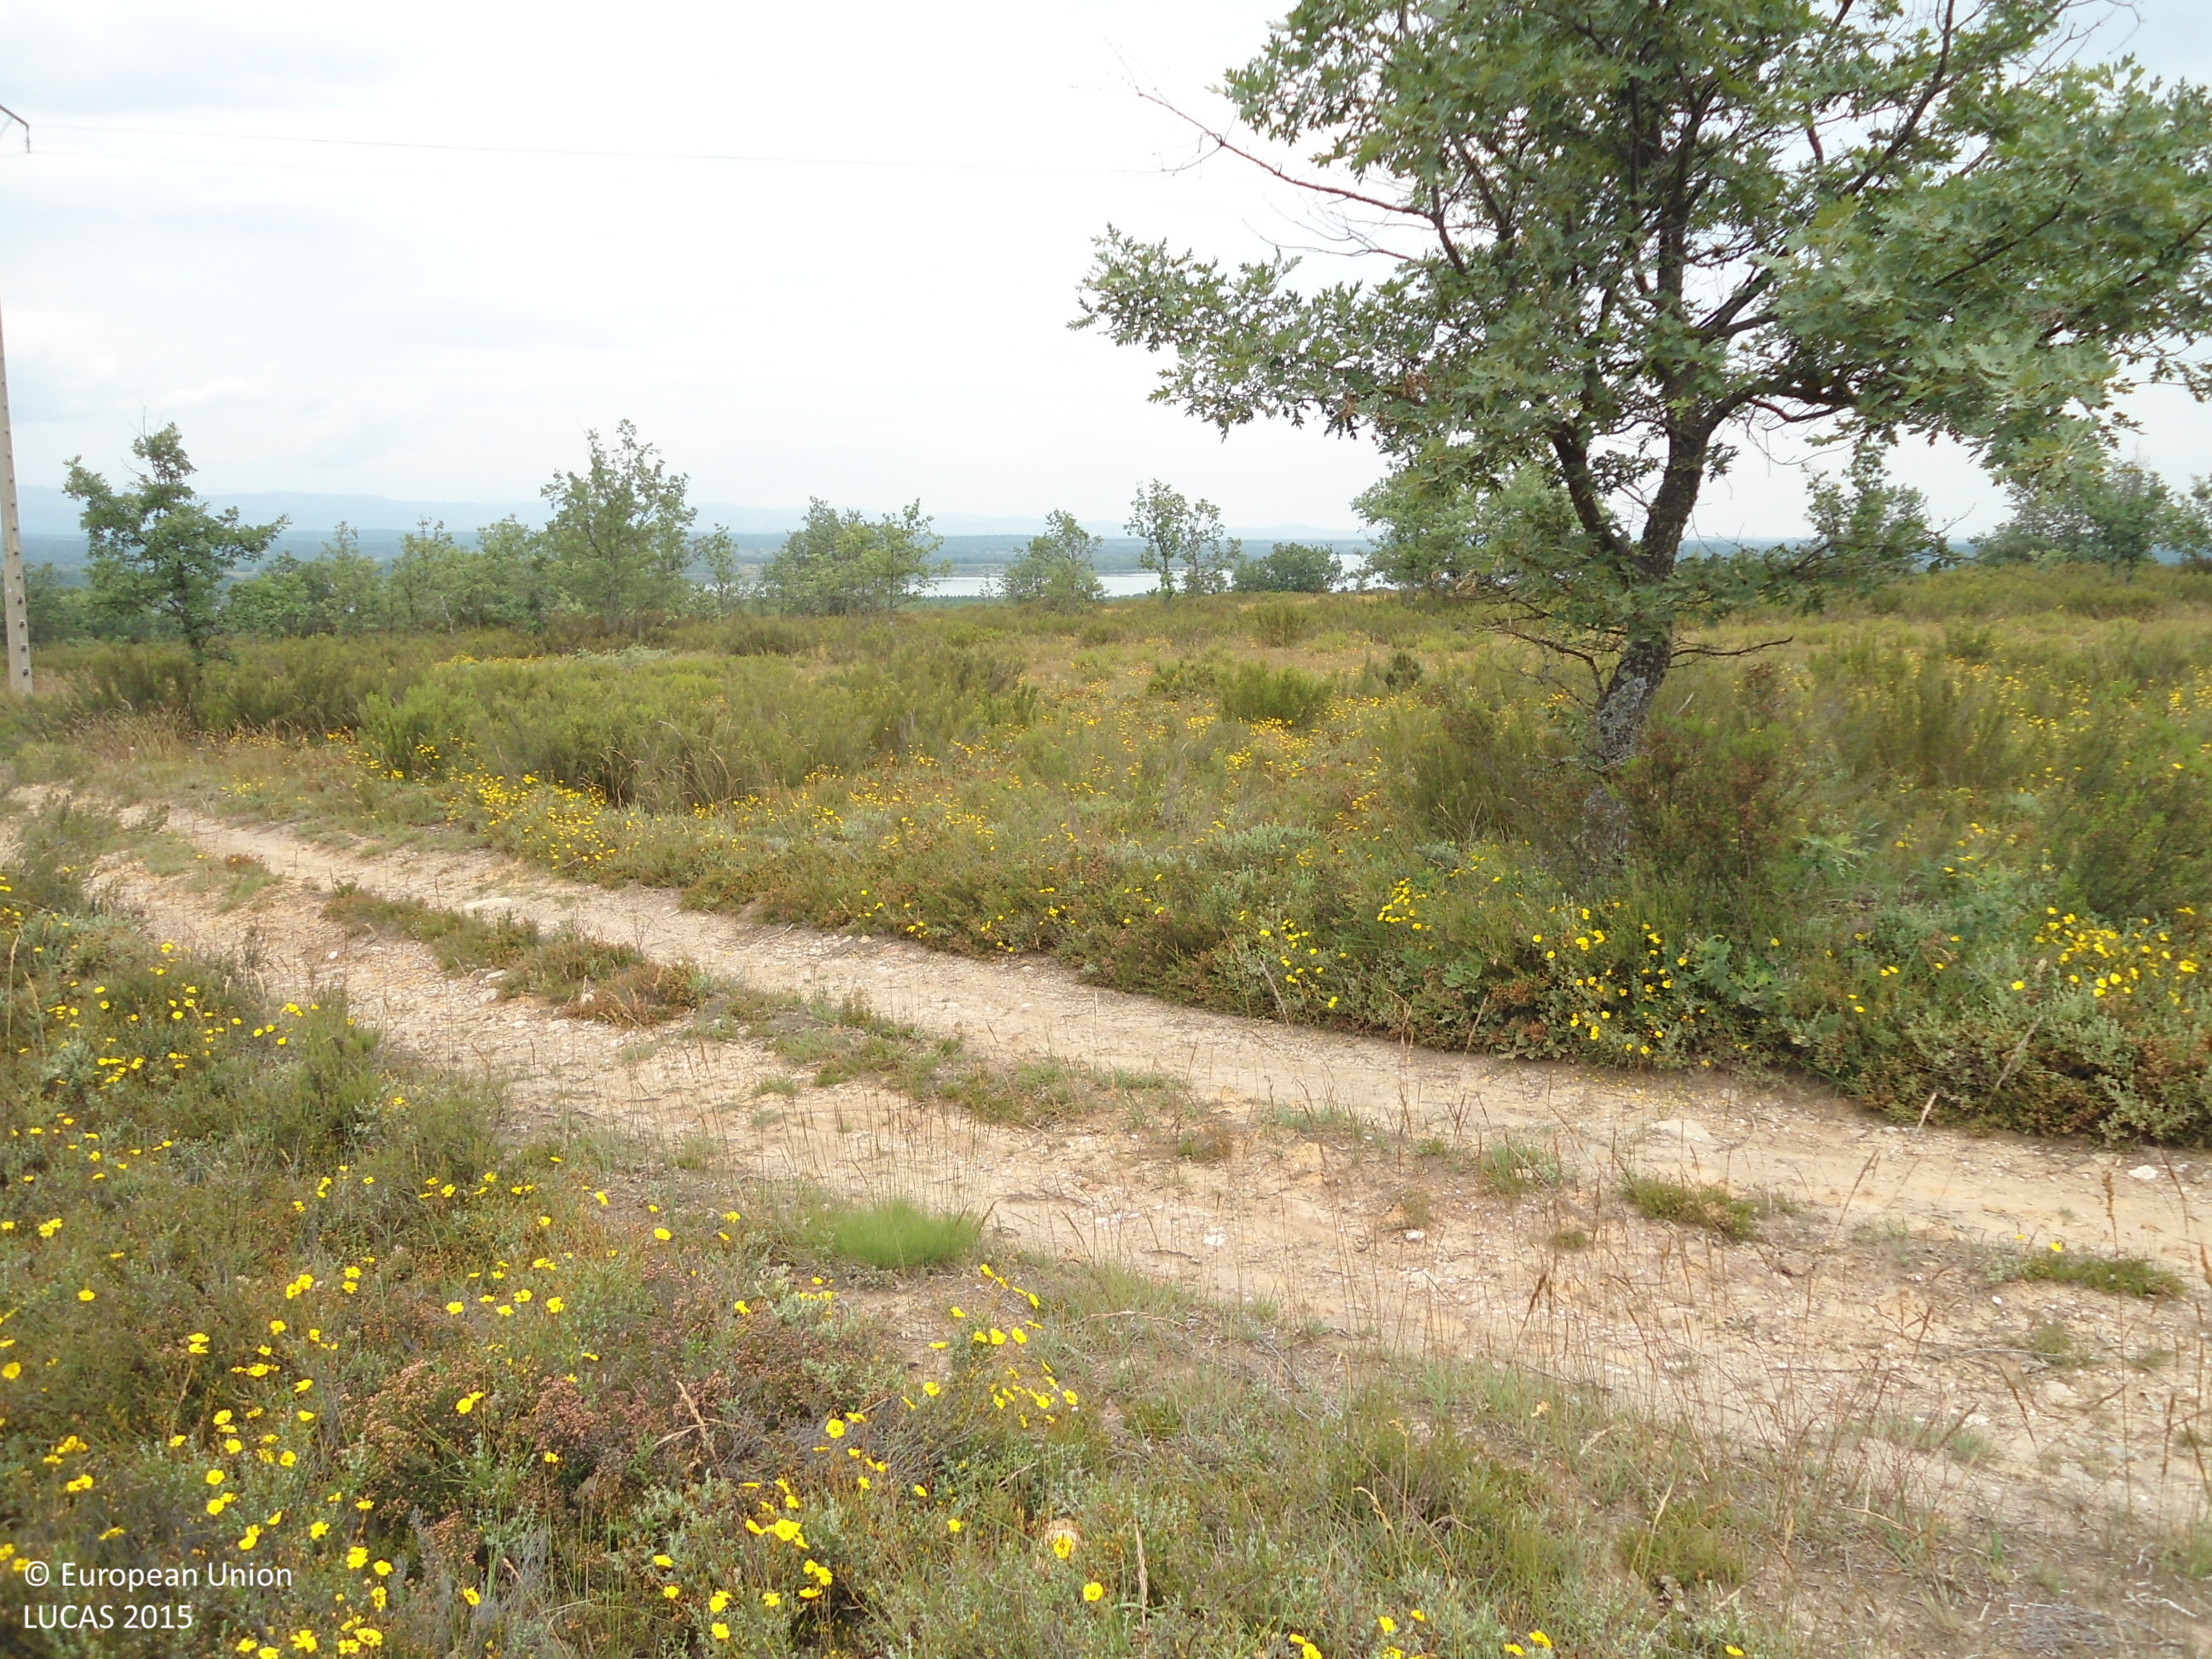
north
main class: Shrubland
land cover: Shrubland with sparse tree cover
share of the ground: > 75 %
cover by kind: shrubs 95 %, broadleaved forest trees 5 %
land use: Semi-natural and natural areas not in use
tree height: < 5 m
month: June
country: ES
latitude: 41.9475
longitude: -6.3051
